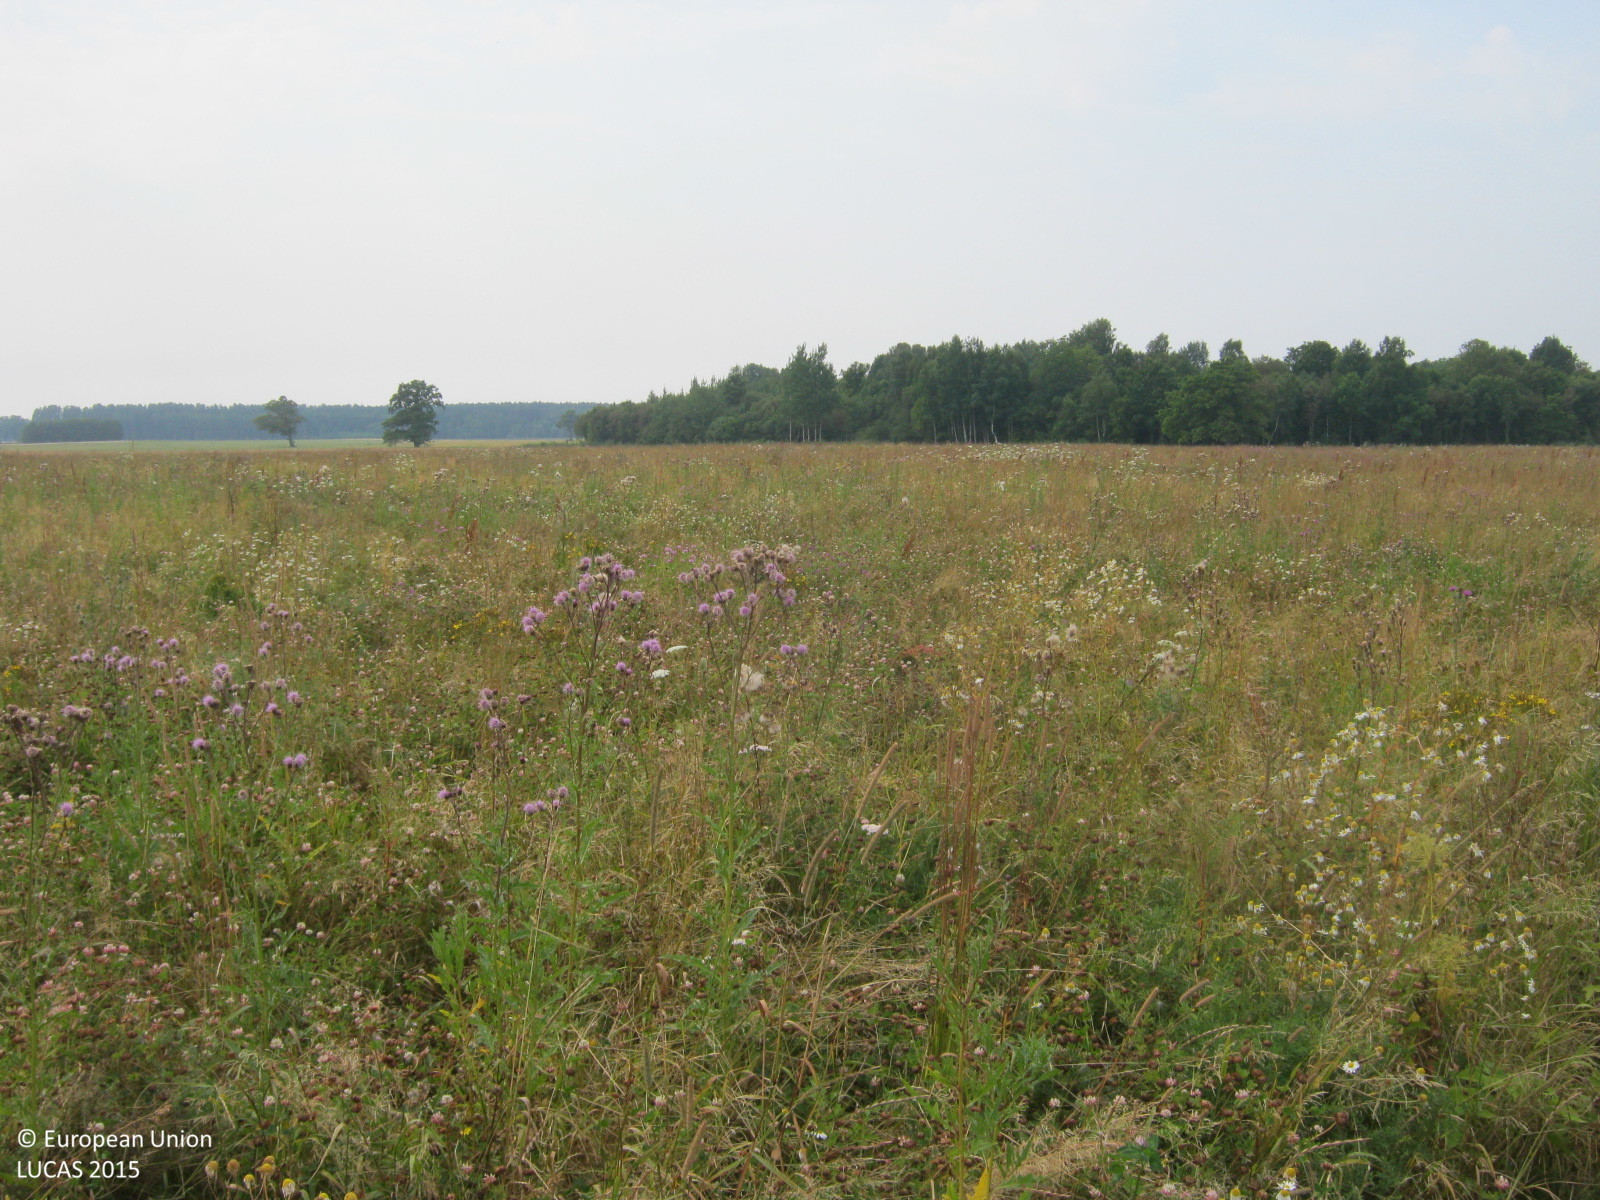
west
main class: Grassland
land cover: Spontaneously vegetated surfaces
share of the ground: > 75 %
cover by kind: herbaceous plants 100 %
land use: Fallow land
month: August
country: LV
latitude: 57.4135
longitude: 24.4576
